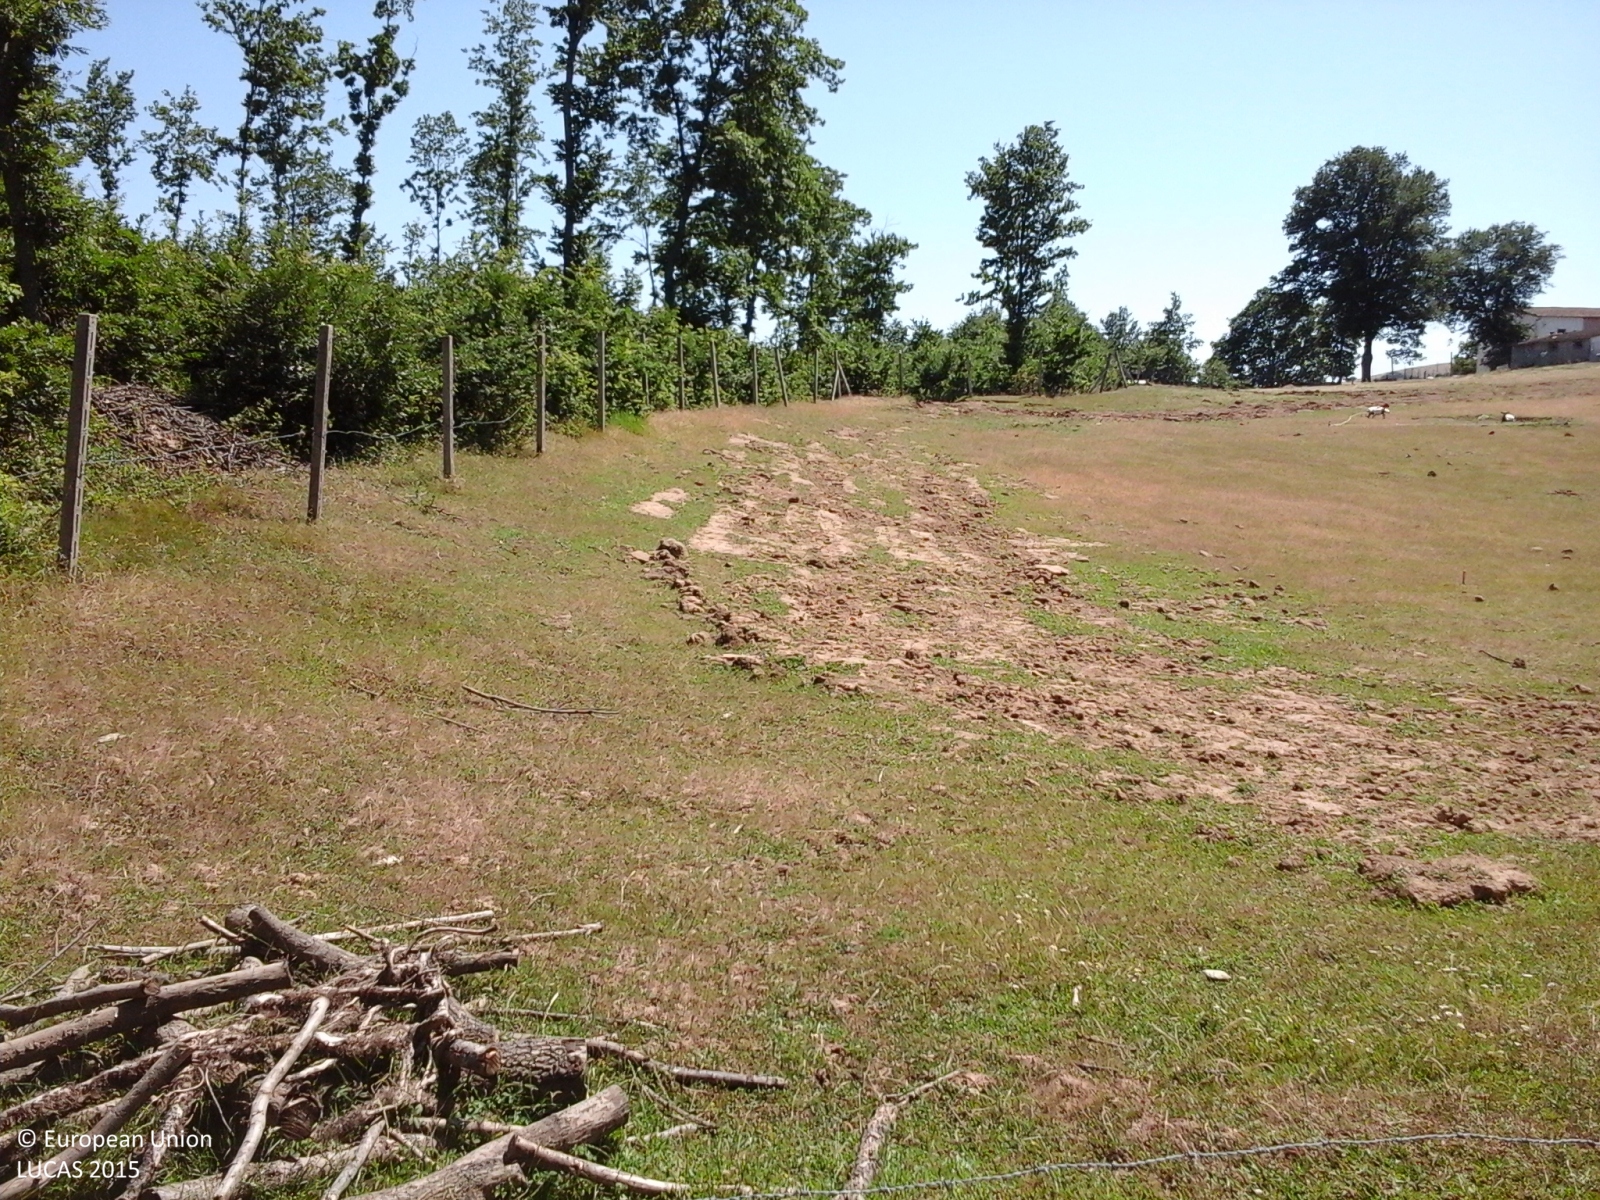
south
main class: Woodland
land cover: Broadleaved woodland
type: thermophilous deciduous forest
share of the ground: > 75 %
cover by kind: broadleaved forest trees 100 %
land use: Forestry
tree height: > 5 m
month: July
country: IT
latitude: 41.6570
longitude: 14.7273
